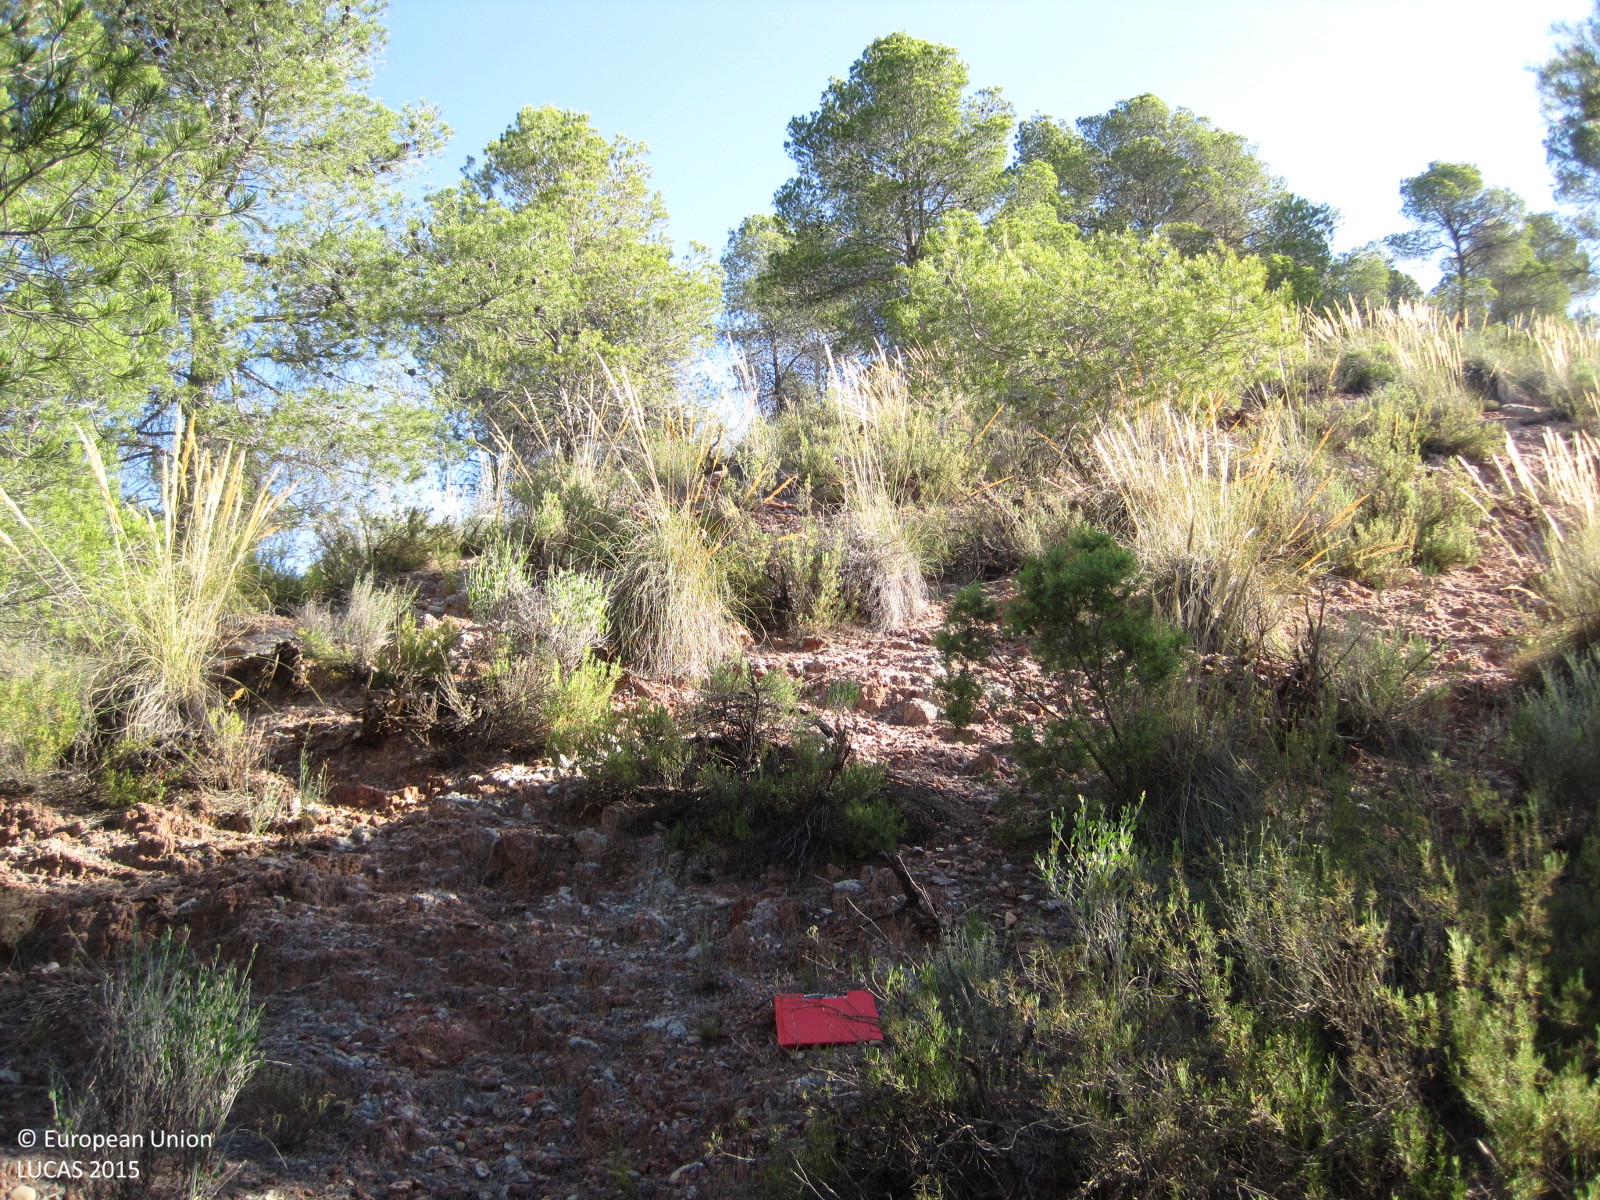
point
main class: Woodland
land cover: Pine dominated coniferous woodland
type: coniferous forest of the mediterranean region
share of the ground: 10 - 25 %
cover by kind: shrubs 30 %, herbaceous plants 25 %, unconsolidated bare surface 25 %, coniferous forest trees 20 %
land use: Forestry
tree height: > 5 m
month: June
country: ES
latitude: 39.2766
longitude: -1.0457
